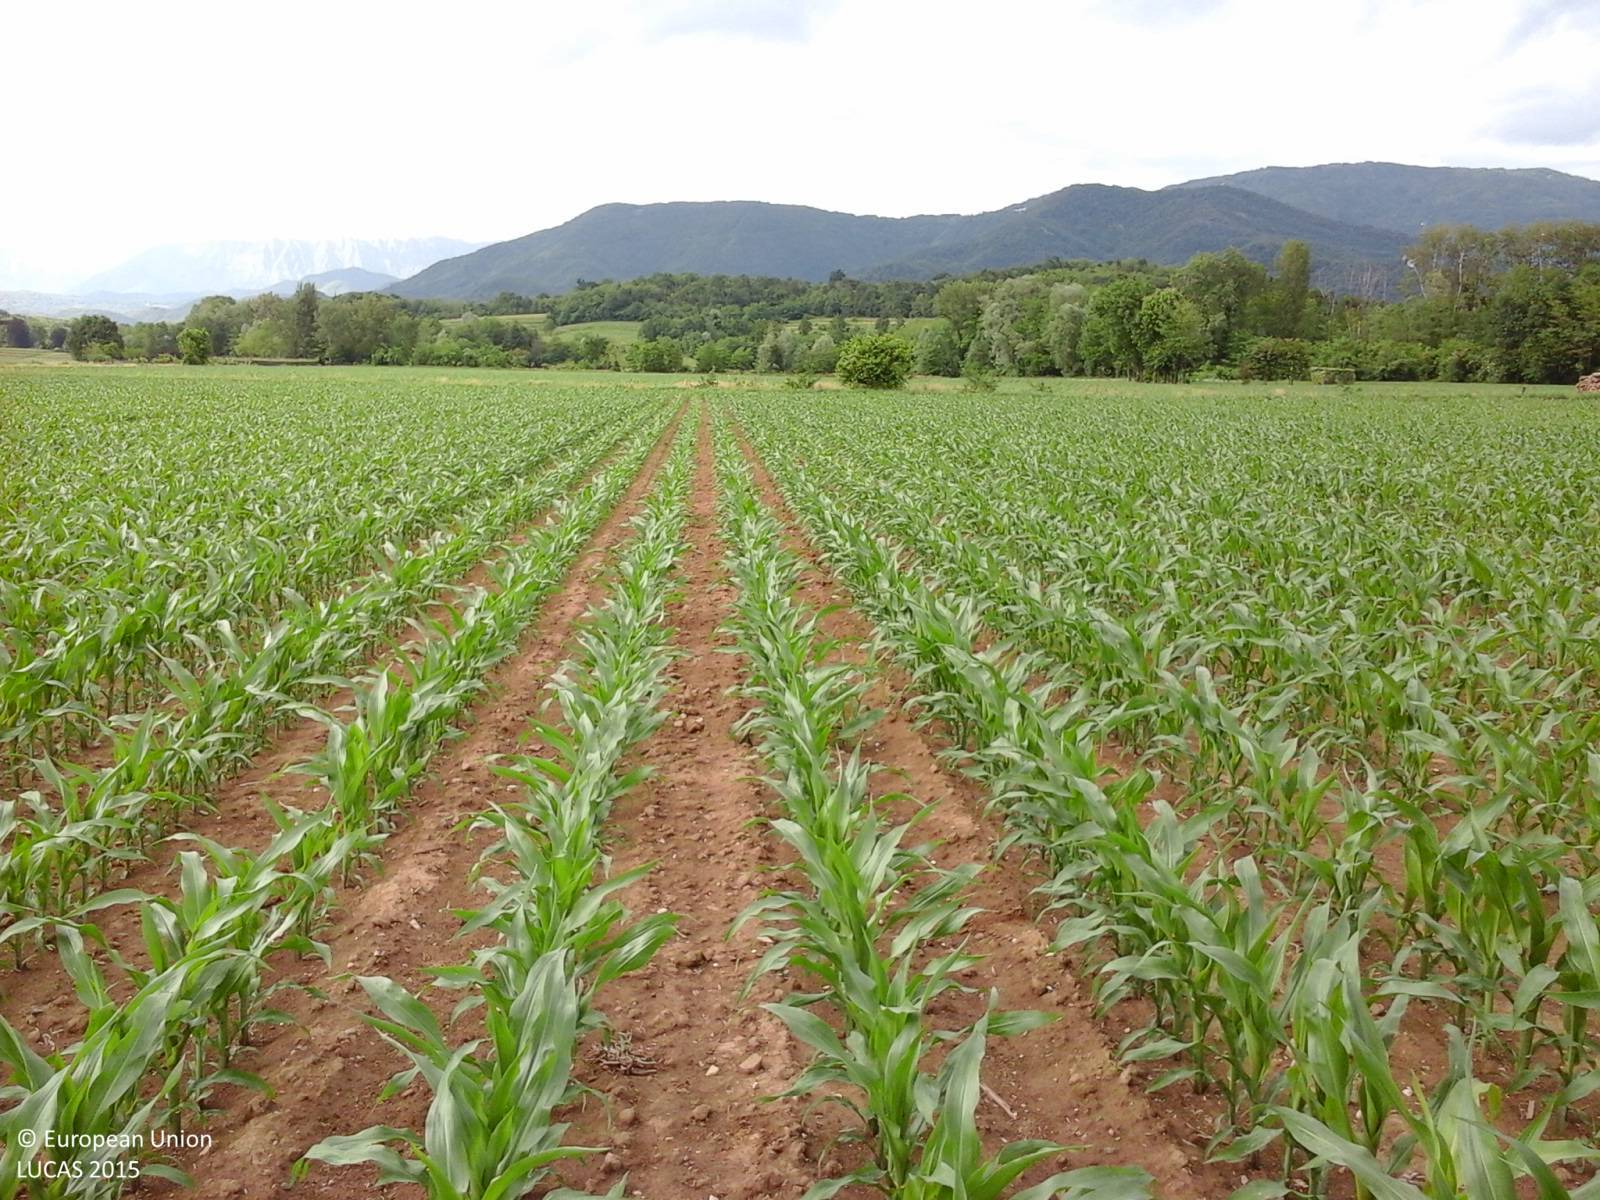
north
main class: Cropland
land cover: Maize
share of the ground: 50 - 75 %
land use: Agriculture (excluding fallow land and kitchen gardens)
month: May
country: IT
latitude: 46.1374
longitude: 13.3232
